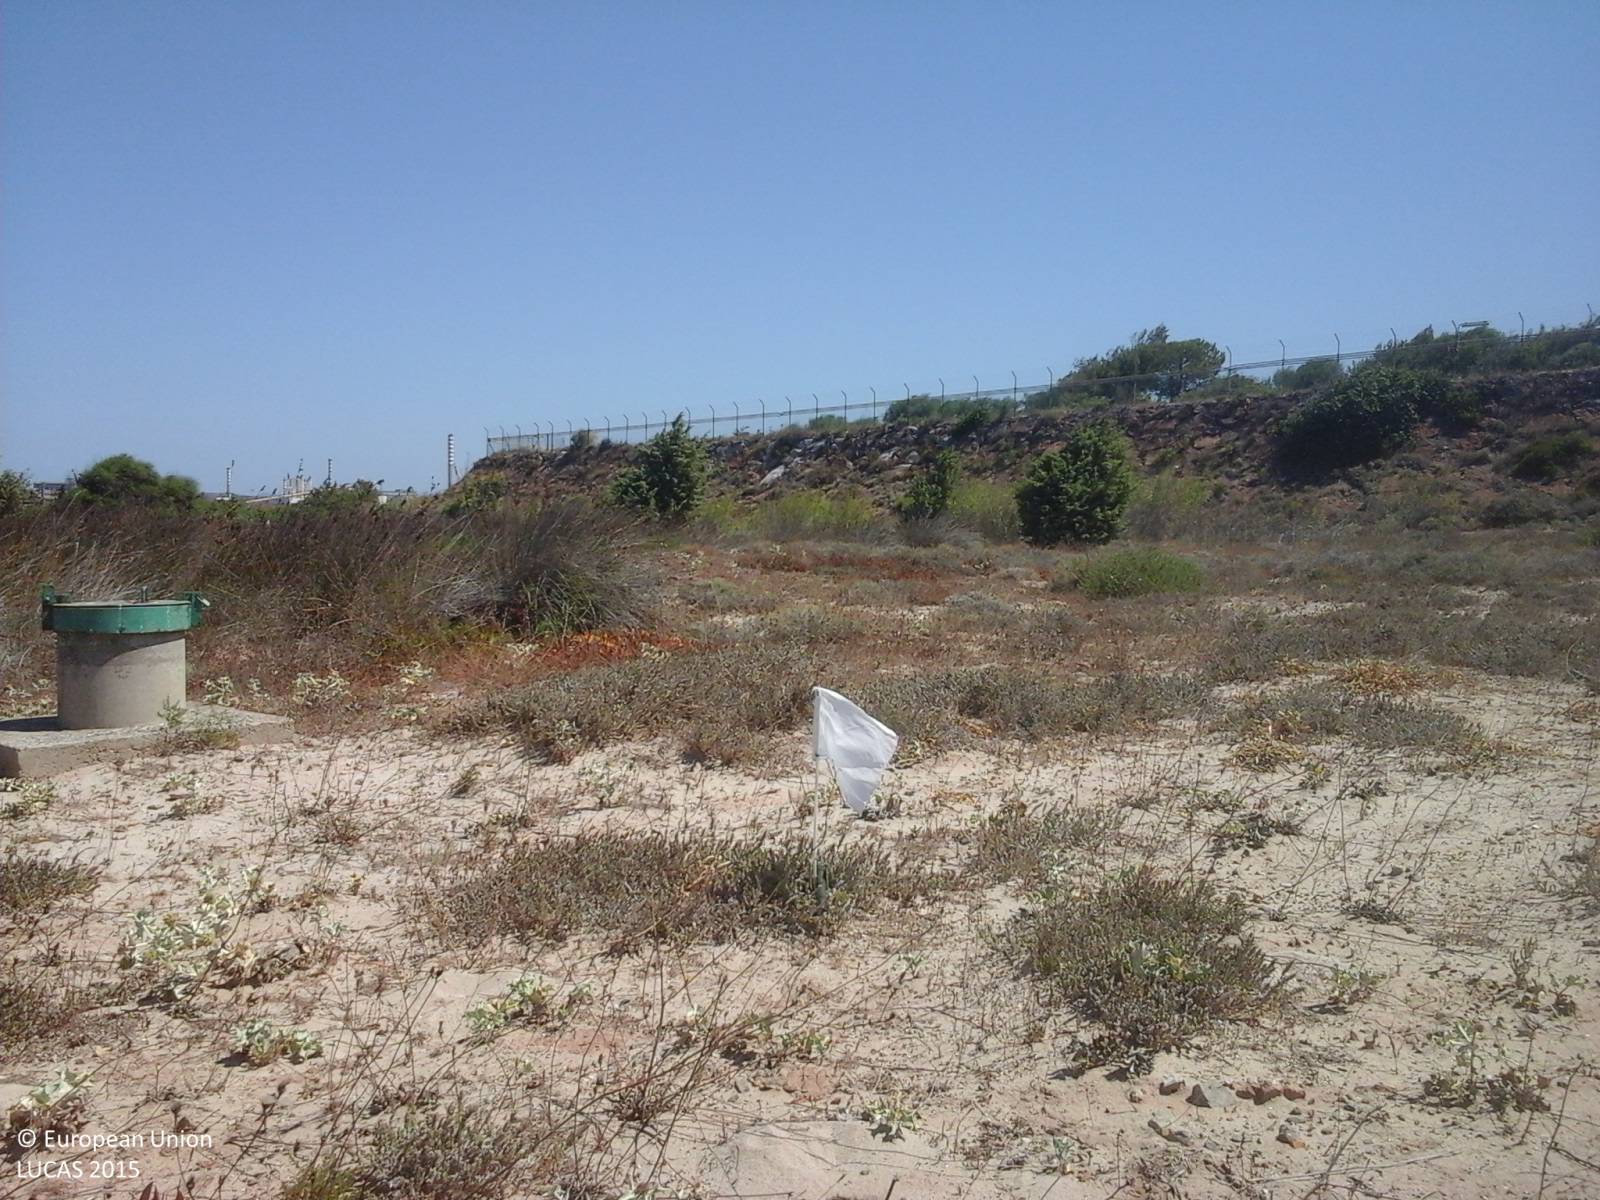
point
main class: Grassland
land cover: Grassland without tree/shrub cover
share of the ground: > 75 %
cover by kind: herbaceous plants 50 %, unconsolidated bare surface 45 %, consolidated bare surface 5 %
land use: Semi-natural and natural areas not in use
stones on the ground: < 10 %
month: July
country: IT
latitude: 39.1855
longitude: 8.4007
